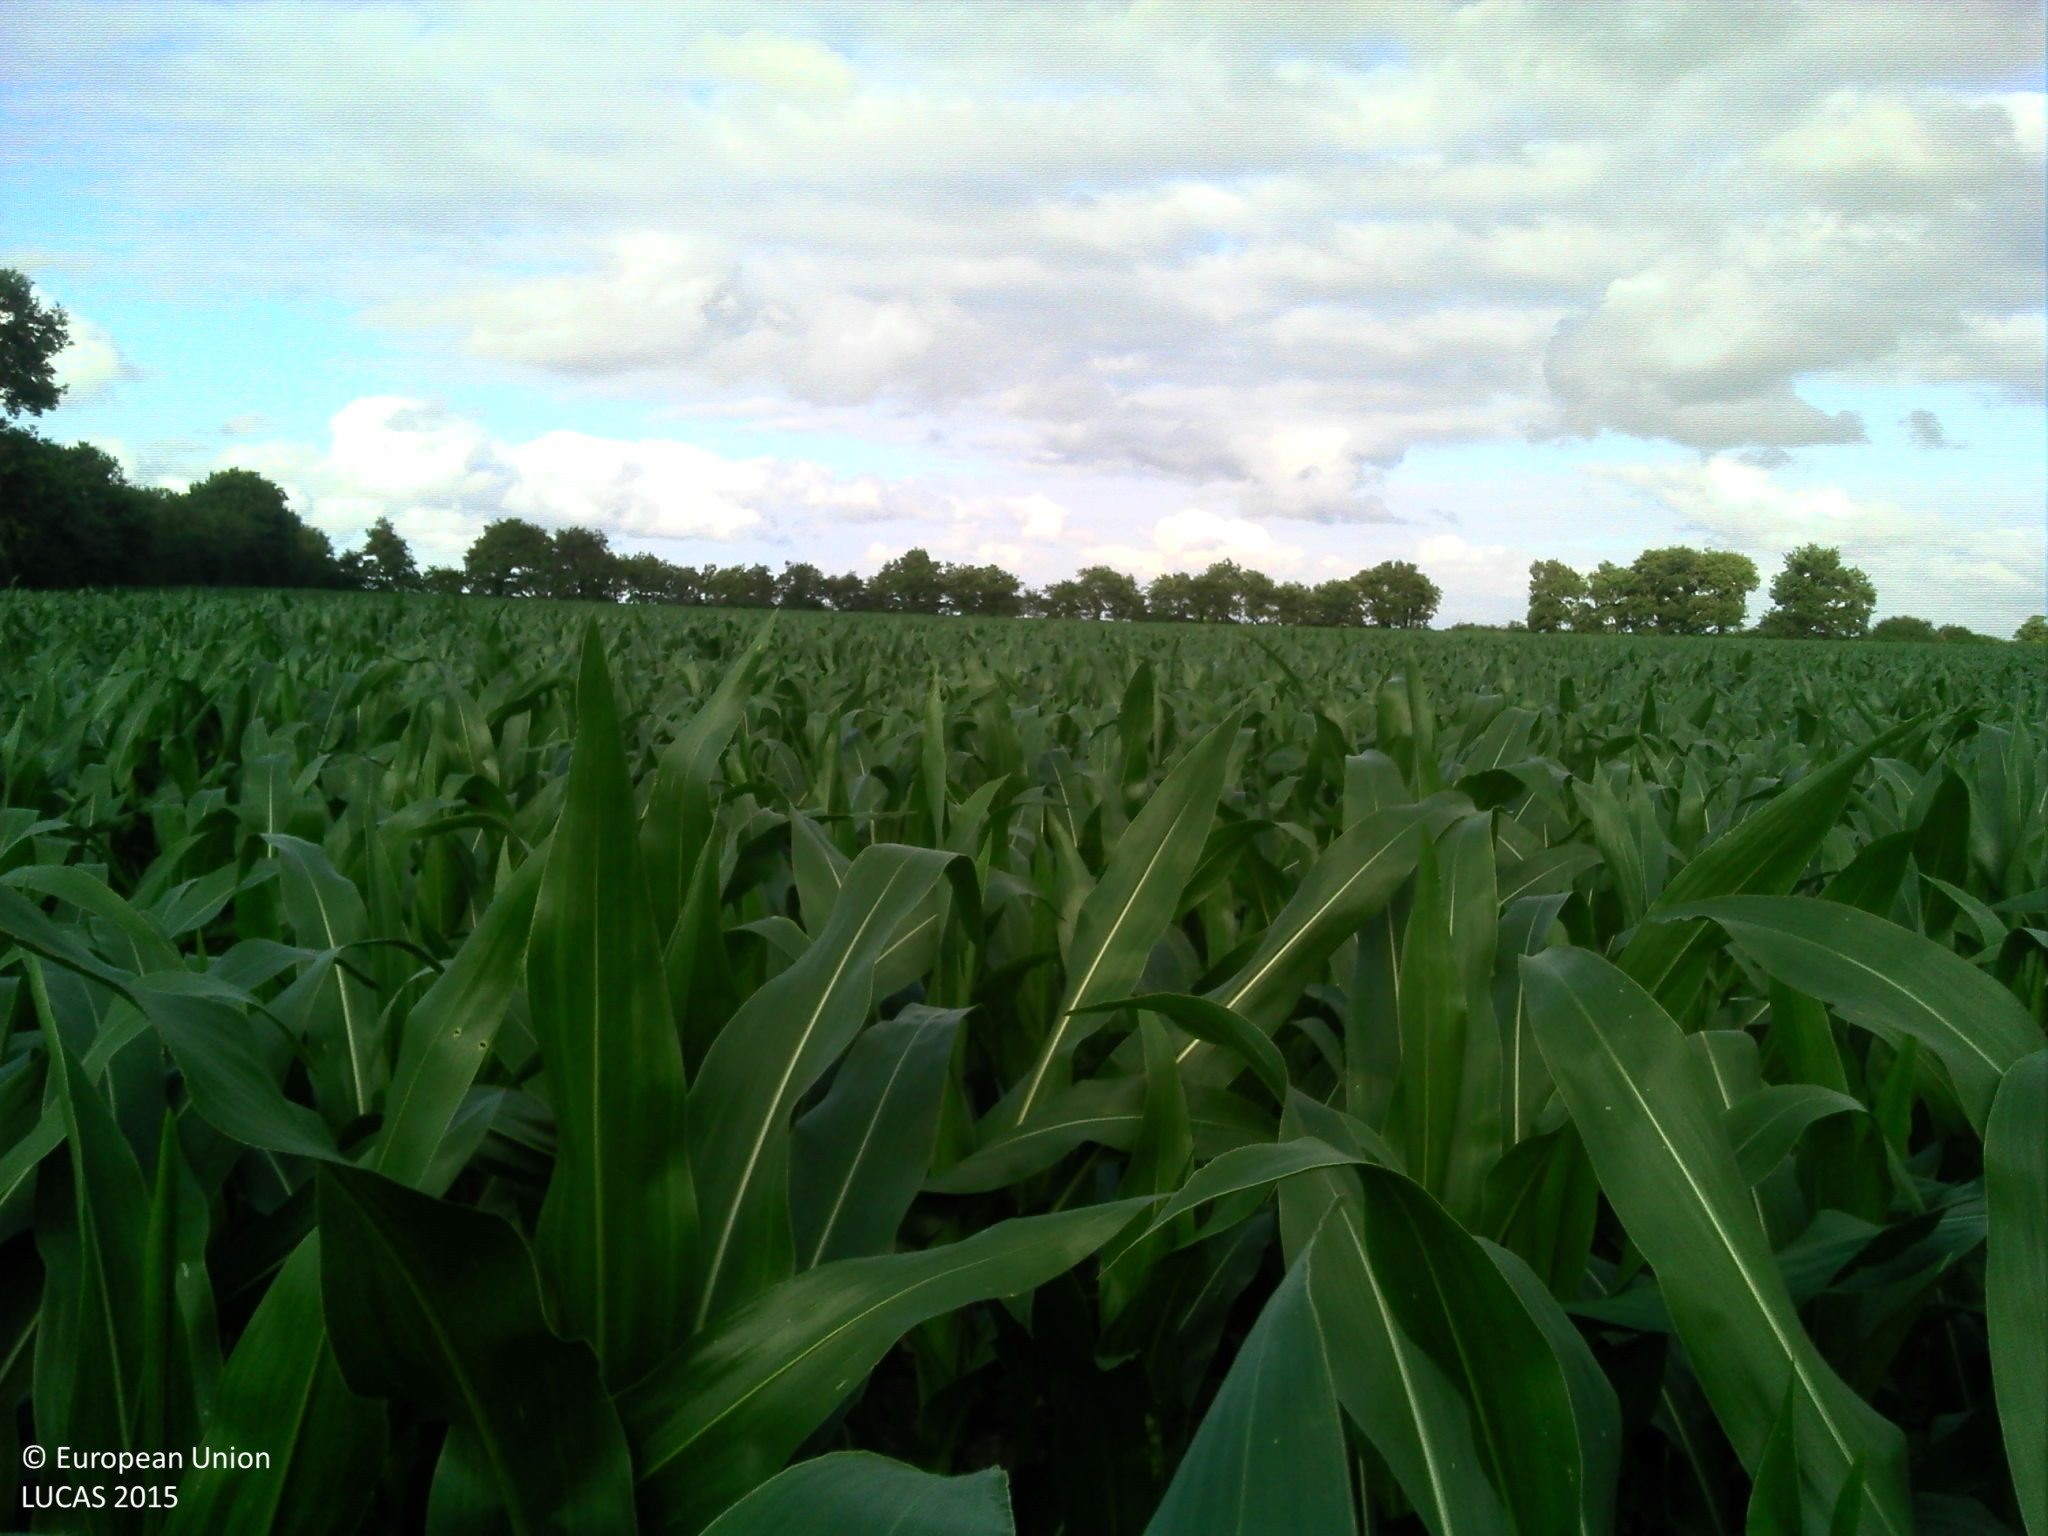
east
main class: Cropland
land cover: Maize
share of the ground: > 75 %
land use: Agriculture (excluding fallow land and kitchen gardens)
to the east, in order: Maize; Ditches and canals; Maize; Abandoned hedges; Other leguminous and mixtures for fodder
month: July
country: FR
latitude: 46.4973
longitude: -1.6227
